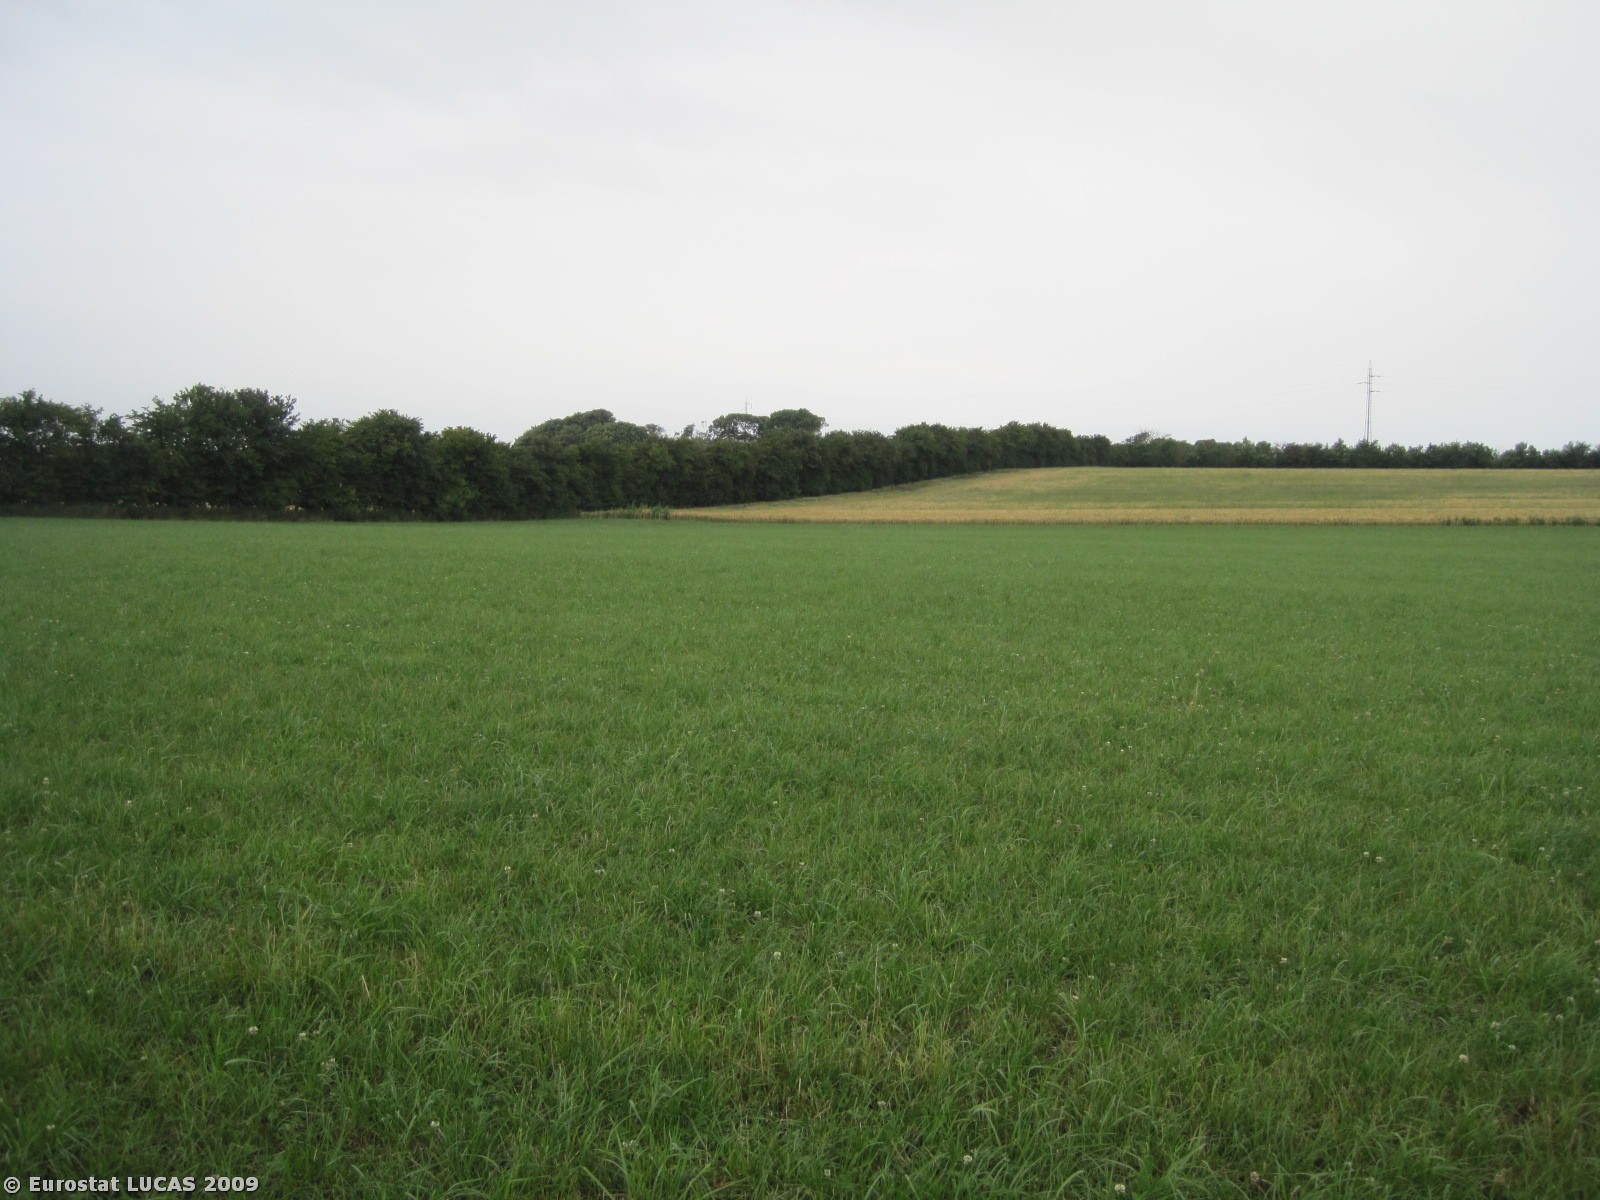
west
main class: Grassland
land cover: Grassland without tree/shrub cover
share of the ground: > 75 %
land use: Agriculture (excluding fallow land and kitchen gardens)
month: July
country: DK
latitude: 56.8271
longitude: 8.5763
